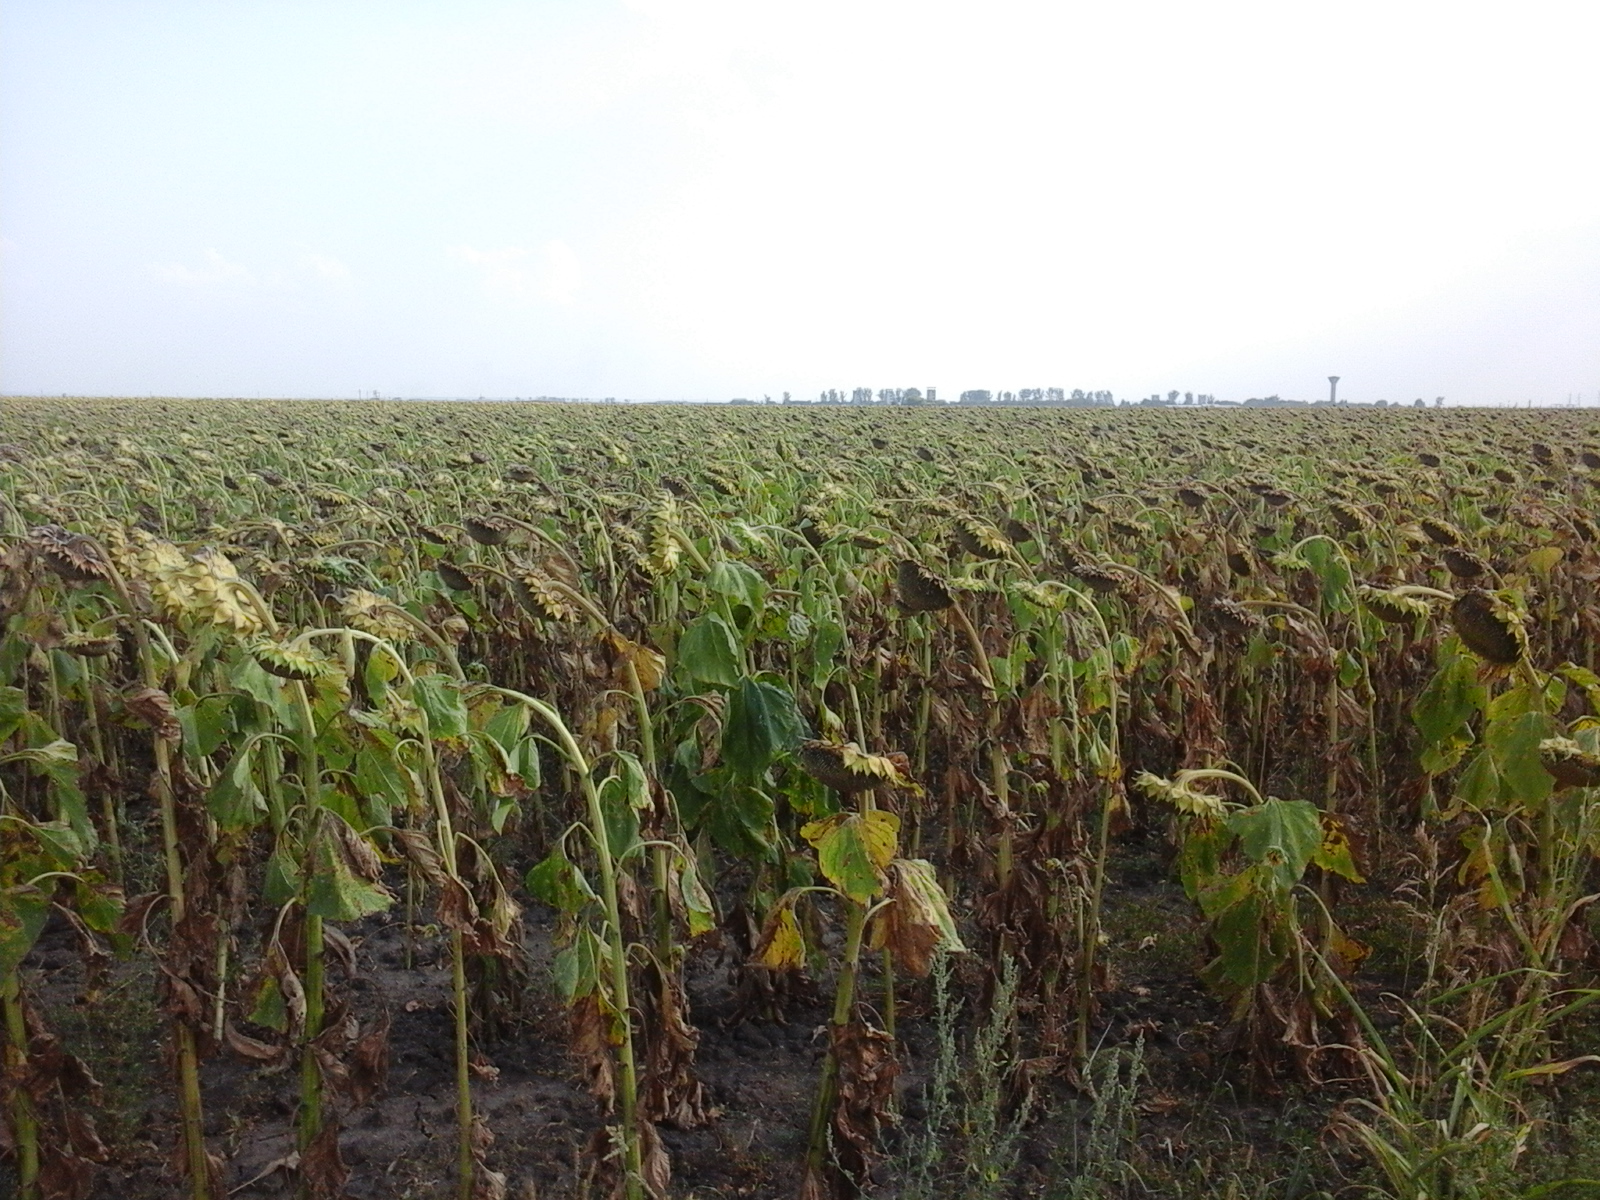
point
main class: Cropland
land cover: Sunflower
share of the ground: > 75 %
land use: Agriculture (excluding fallow land and kitchen gardens)
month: August
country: RO
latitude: 44.0446
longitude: 23.3891
